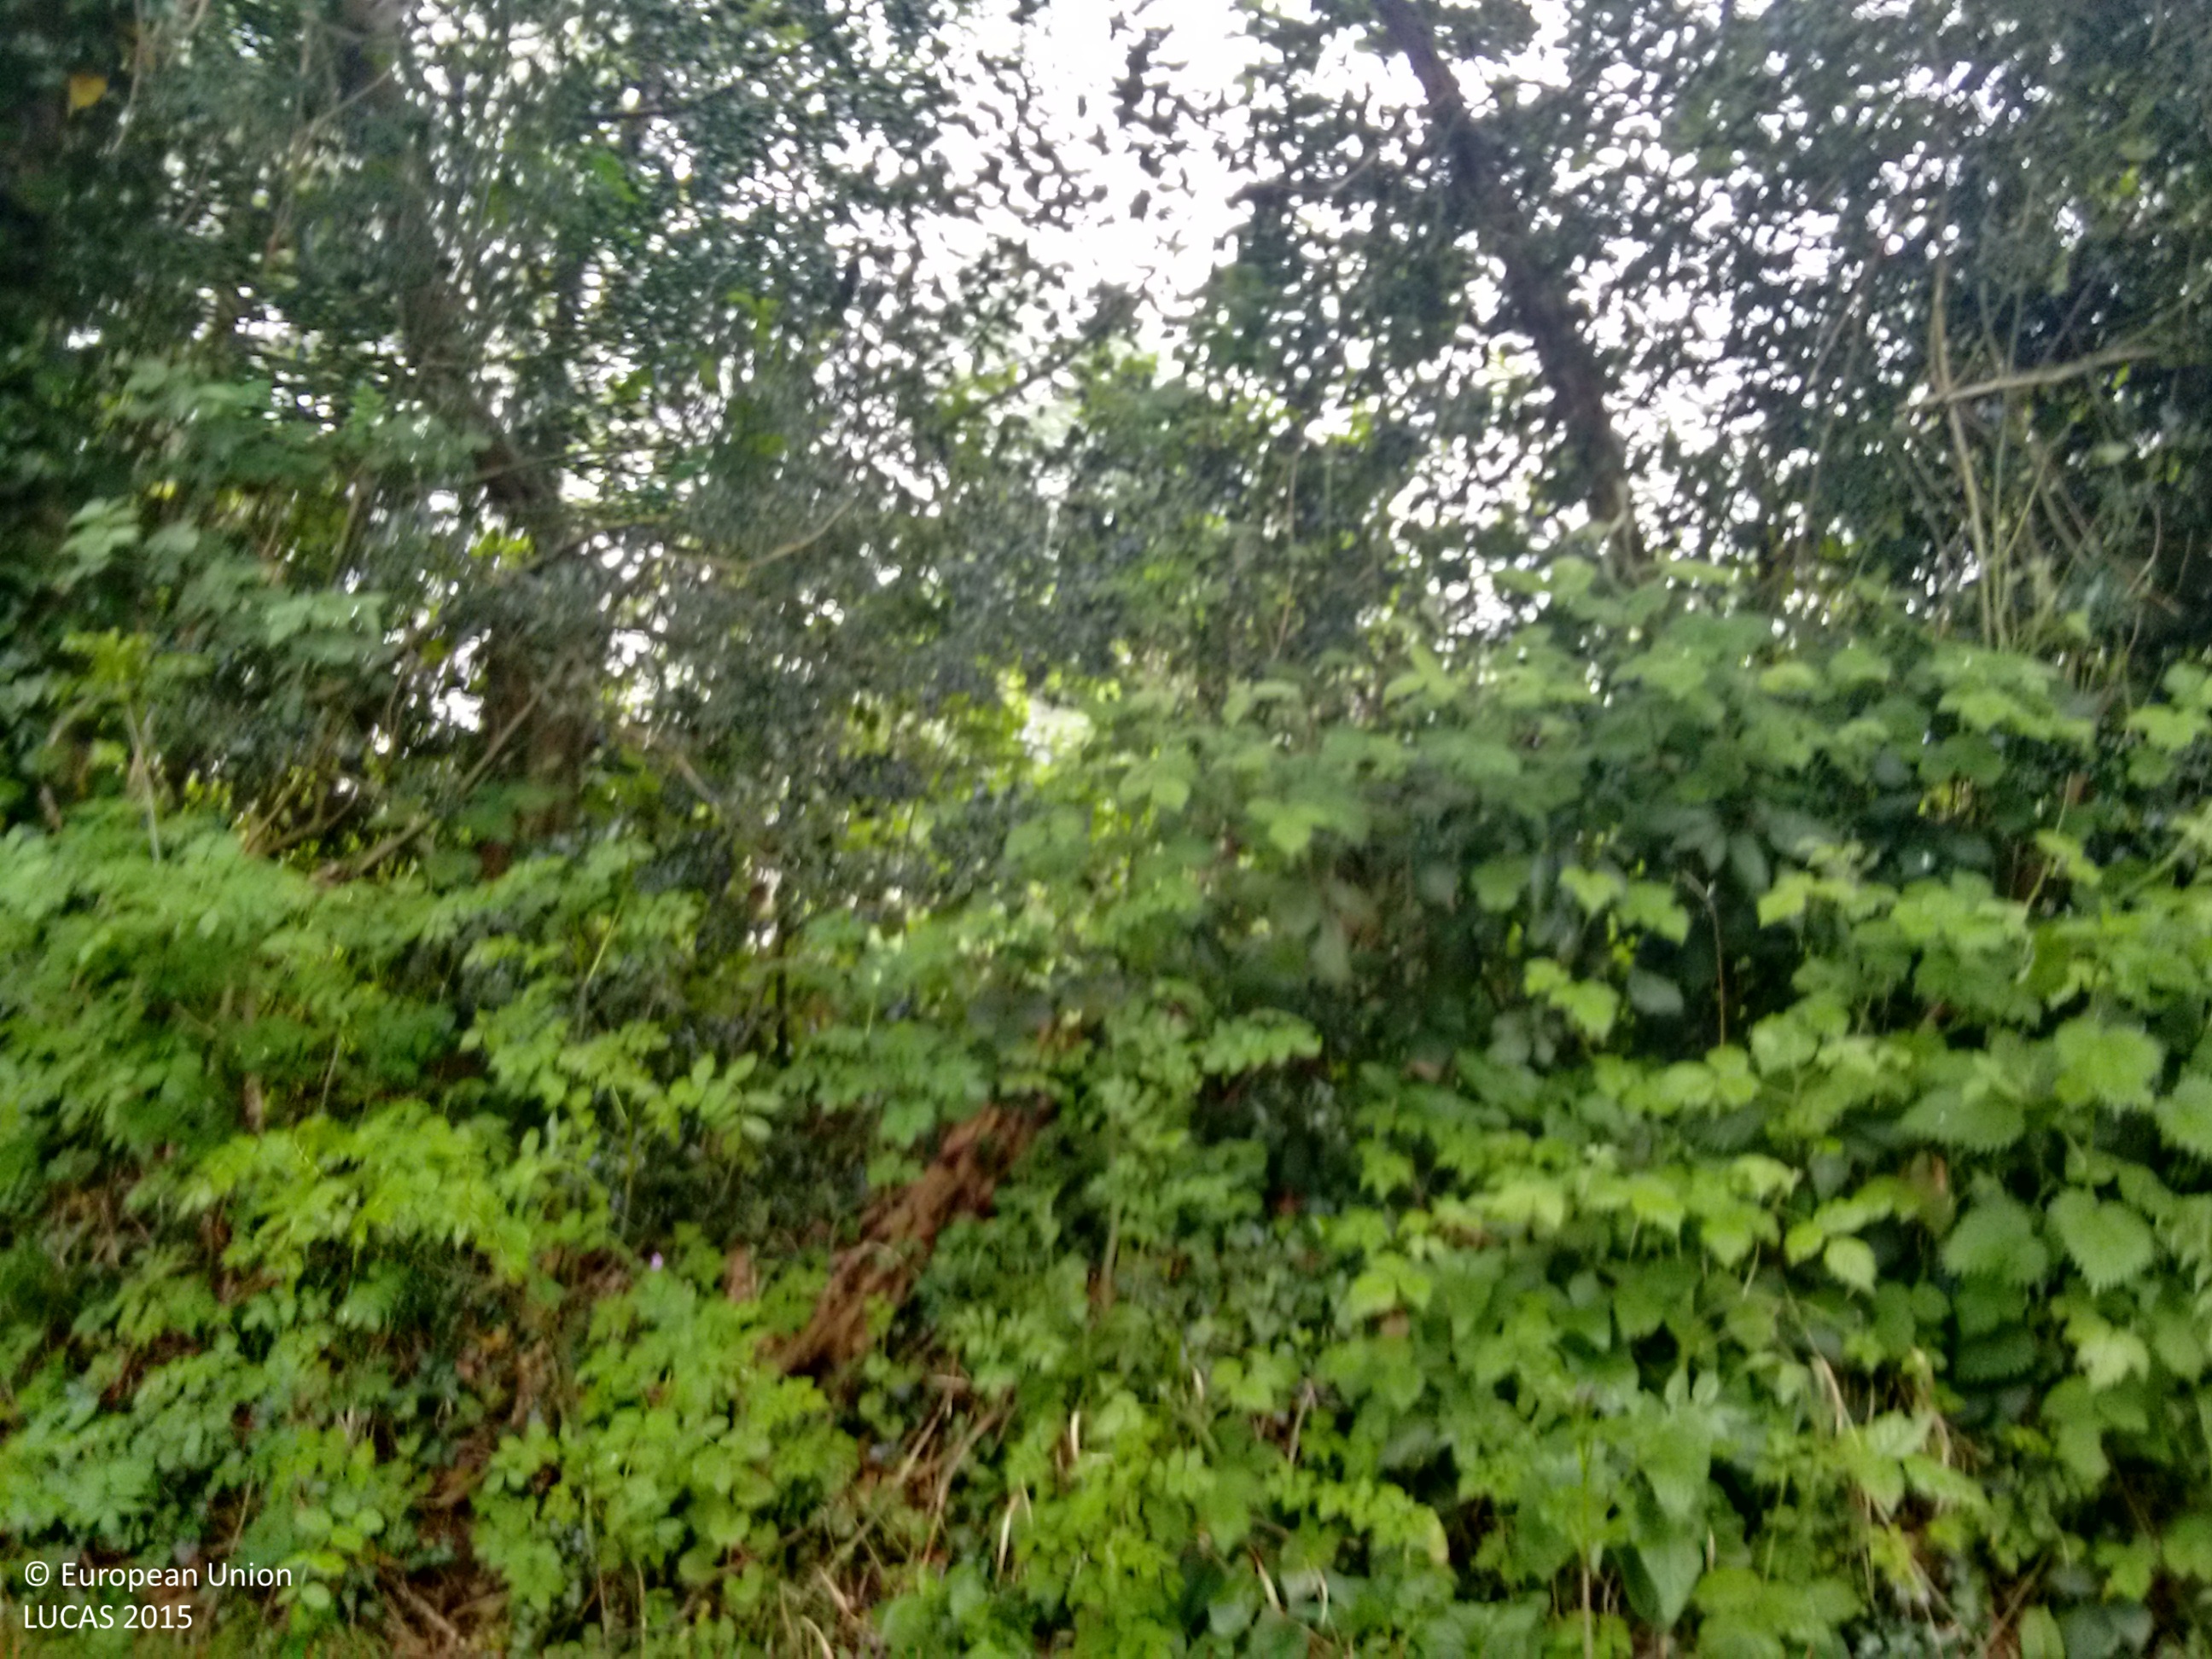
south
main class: Grassland
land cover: Grassland without tree/shrub cover
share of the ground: 50 - 75 %
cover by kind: herbaceous plants 75 %, unconsolidated bare surface 25 %
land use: Agriculture (excluding fallow land and kitchen gardens)
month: May
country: GB
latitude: 51.0772
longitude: -2.3244
